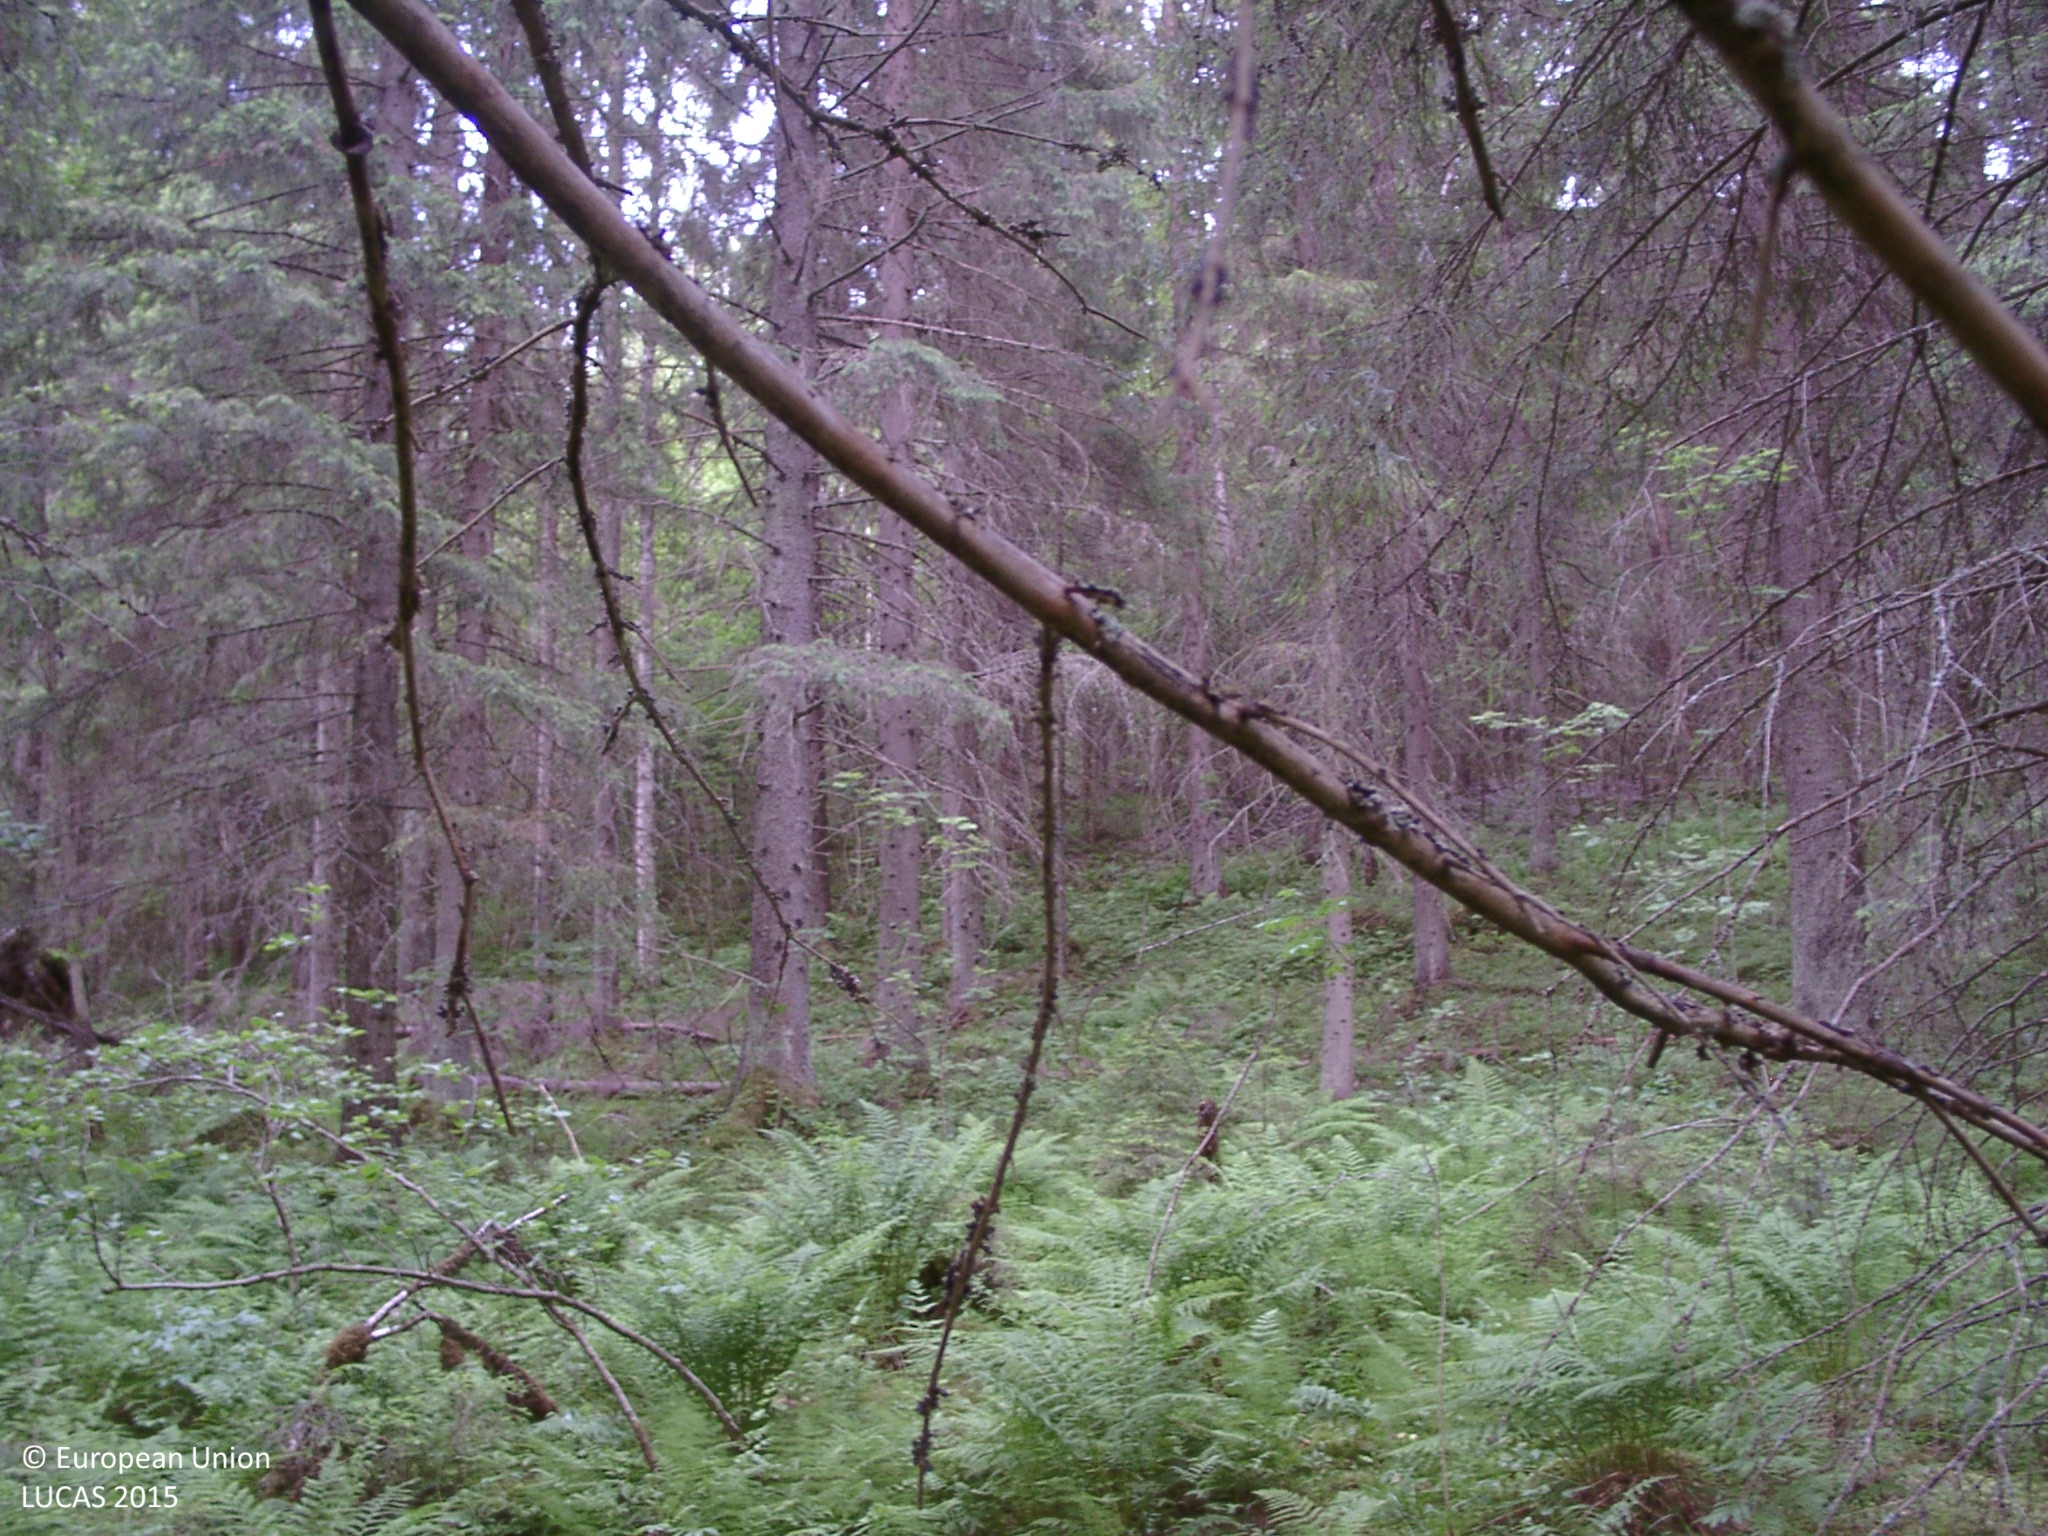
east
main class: Woodland
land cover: Spruce dominated mixed woodland
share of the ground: 50 - 75 %
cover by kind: coniferous forest trees 45 %, herbaceous plants 30 %, broadleaved forest trees 20 %, lichens and mosses 5 %
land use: Forestry
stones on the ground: < 10 %
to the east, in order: Spruce dominated mixed woodland; Rivers and streams; Spruce dominated coniferous woodland; Spruce dominated mixed woodland; Spruce dominated coniferous woodland
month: July
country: FI
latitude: 62.0102
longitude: 25.4528
